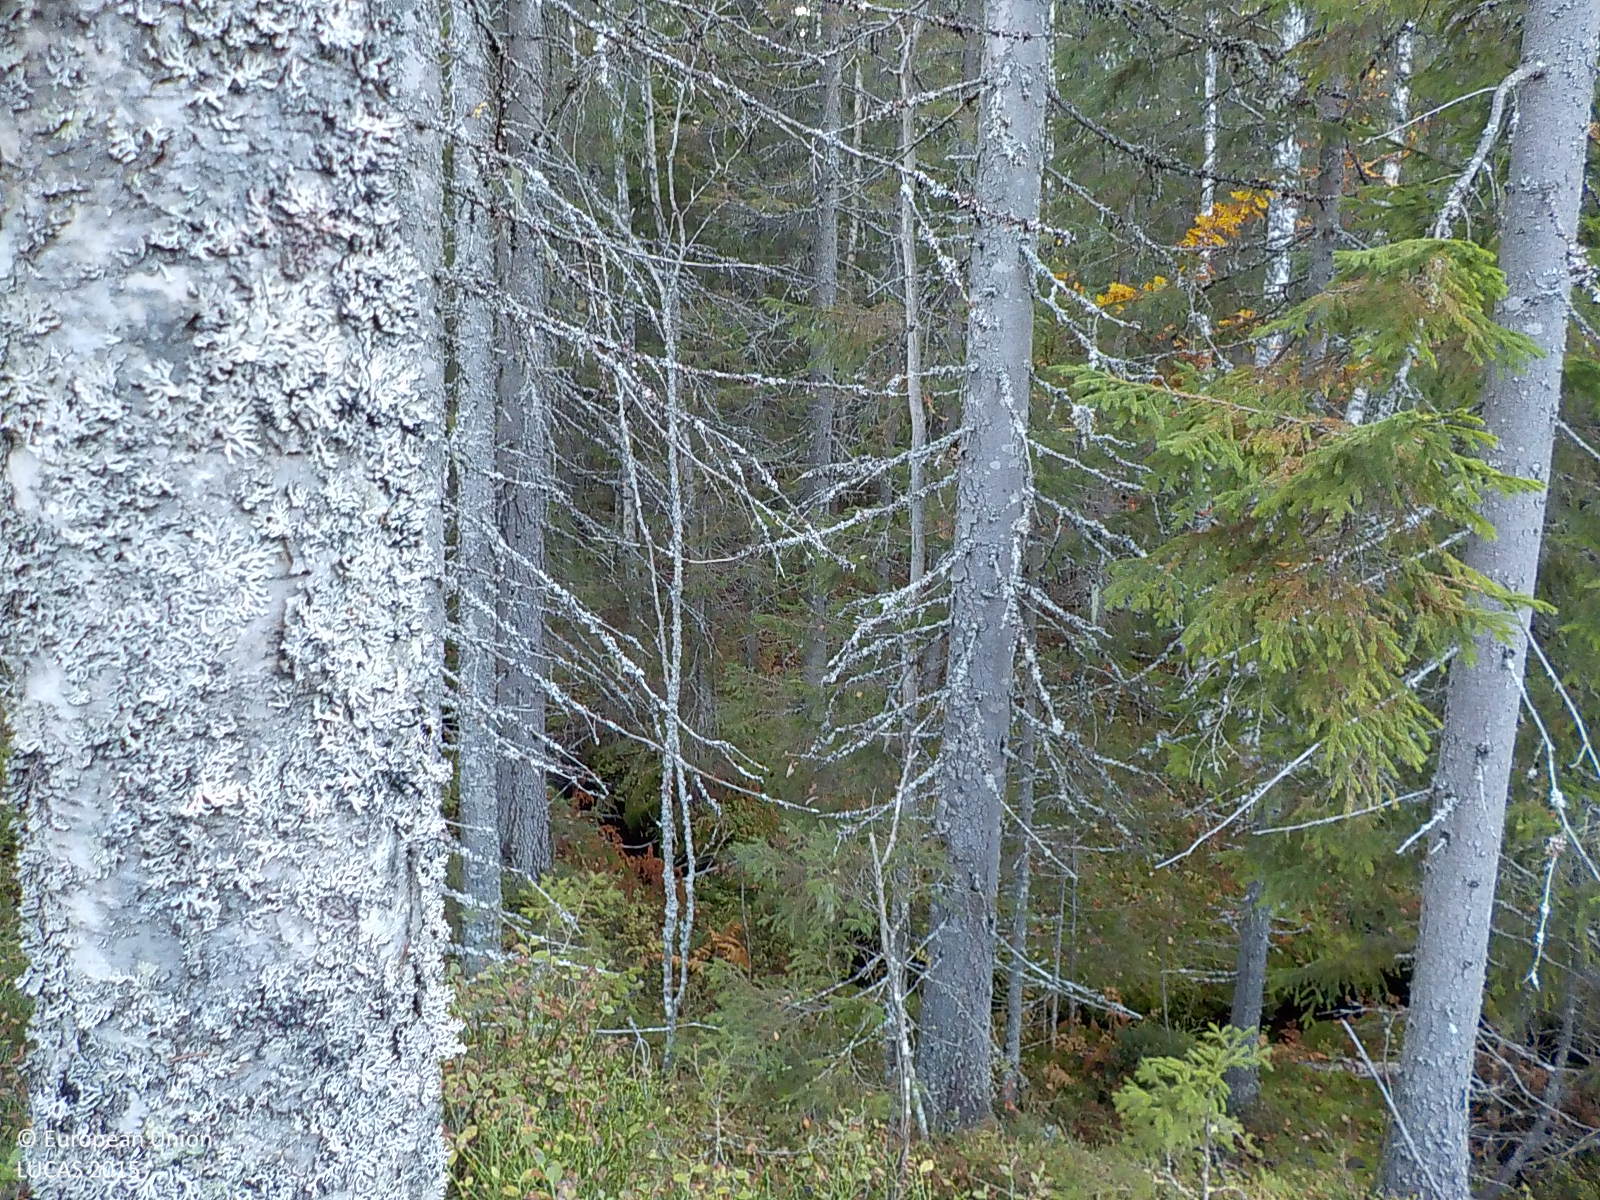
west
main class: Woodland
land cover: Spruce dominated mixed woodland
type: boreal forest
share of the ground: > 75 %
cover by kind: coniferous forest trees 55 %, broadleaved forest trees 20 %, shrubs 15 %, herbaceous plants 10 %
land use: Forestry
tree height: > 5 m
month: October
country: SE
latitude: 63.1995
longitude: 18.3070
